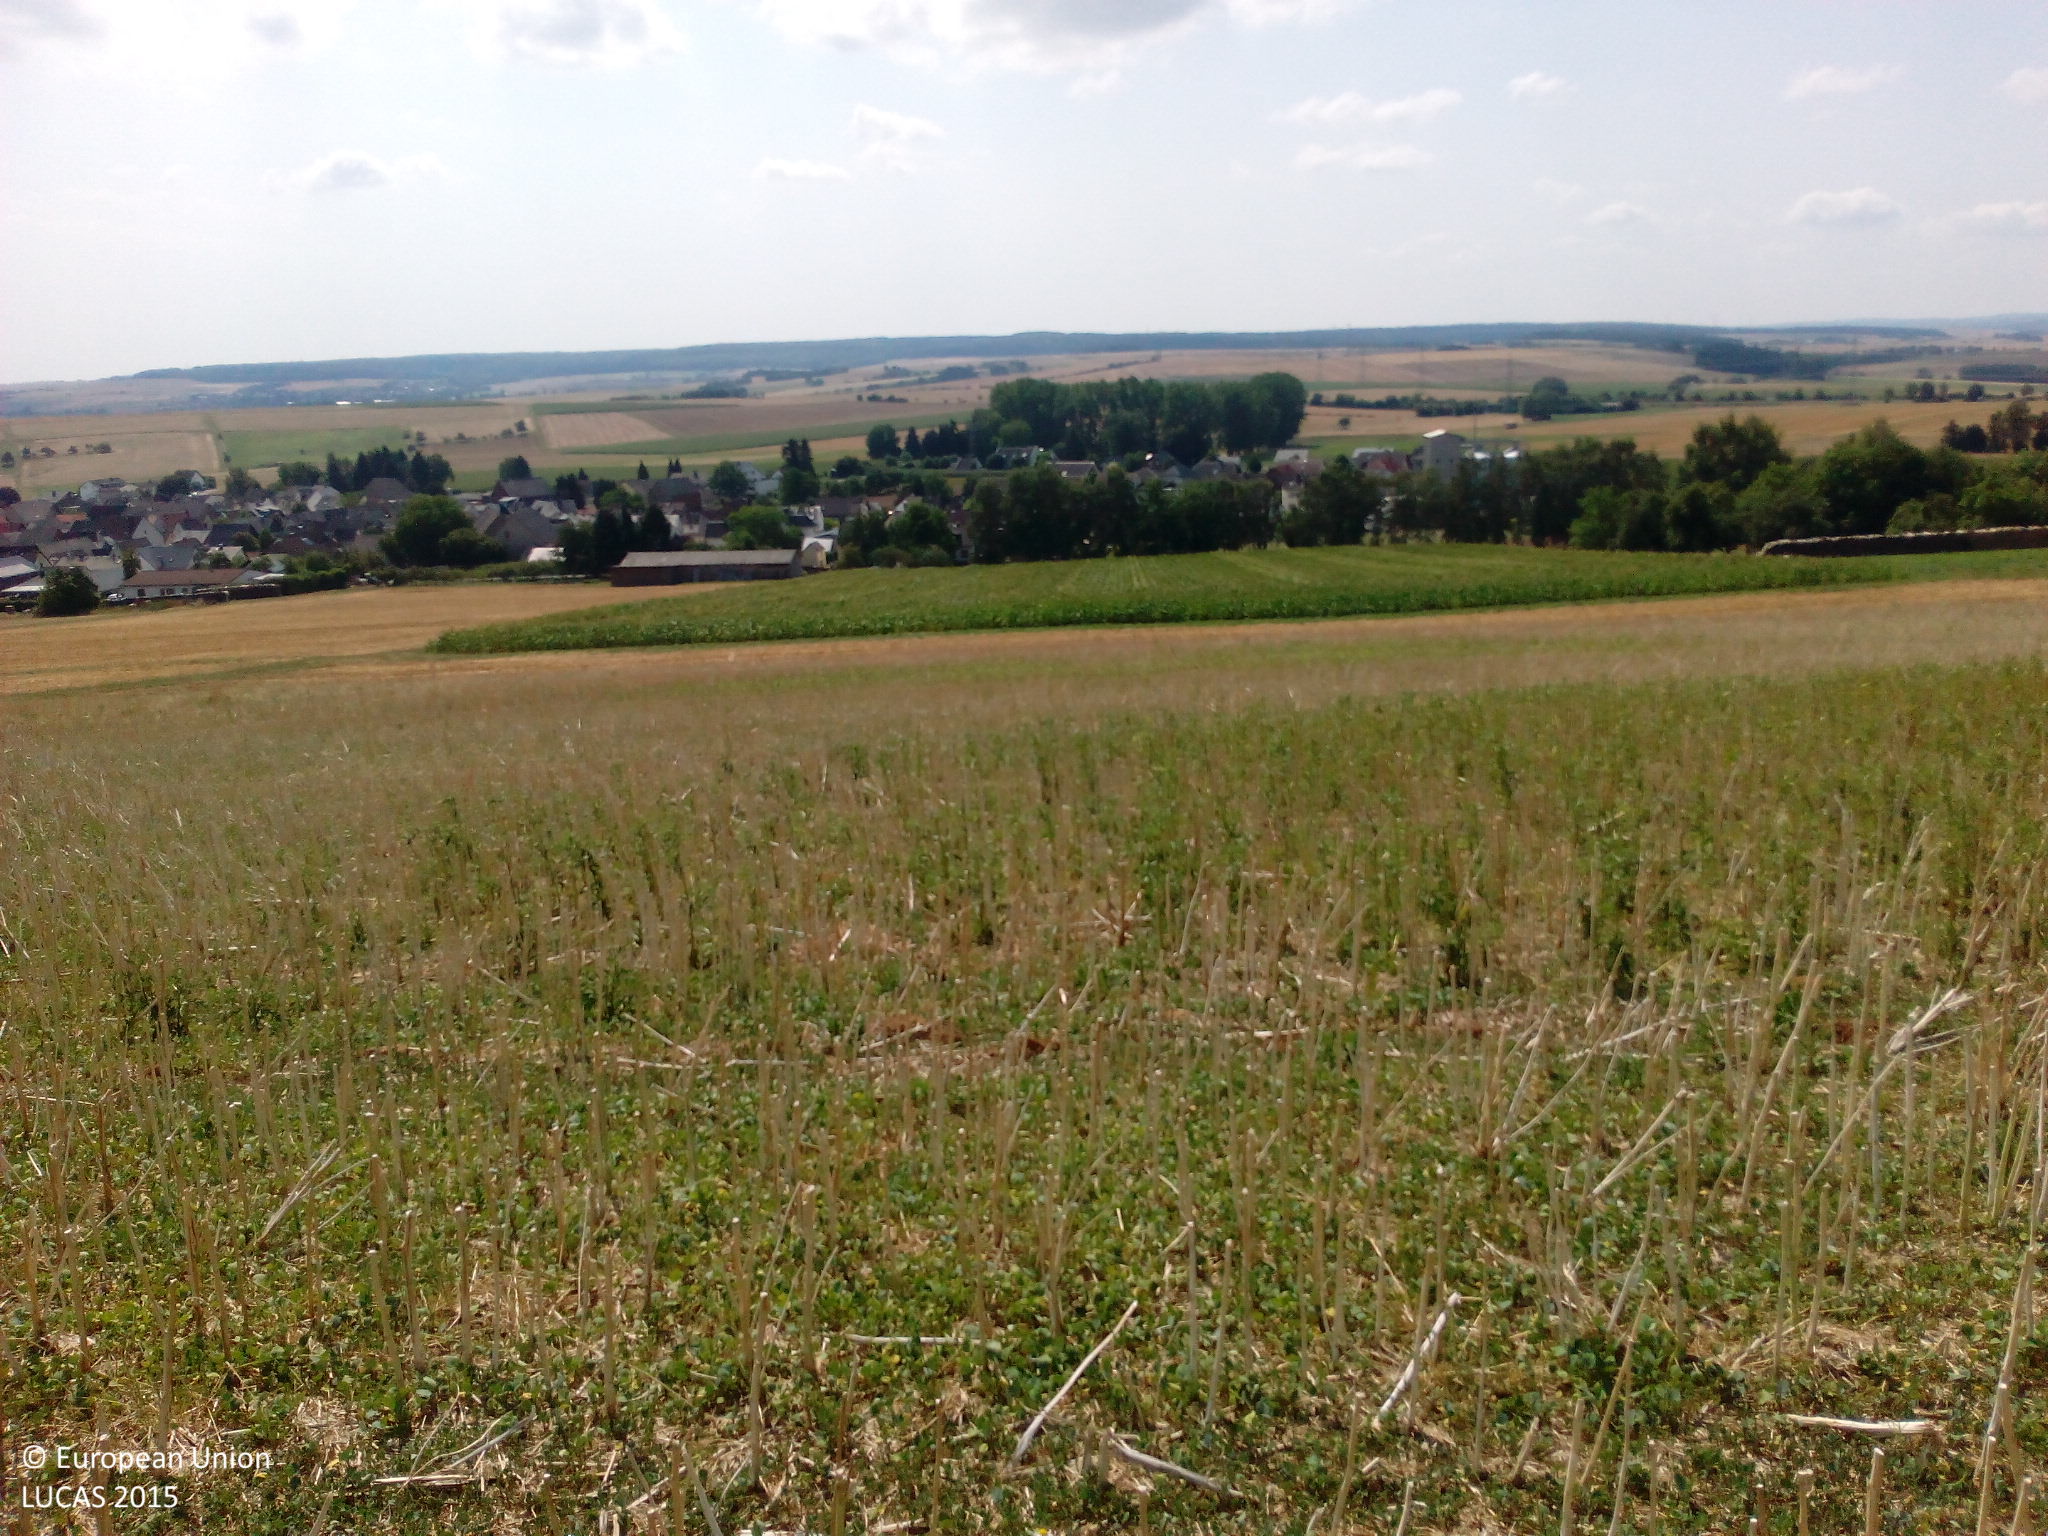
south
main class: Cropland
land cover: Rape and turnip rape
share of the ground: < 10 %
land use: Agriculture (excluding fallow land and kitchen gardens)
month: August
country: DE
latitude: 50.3488
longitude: 8.1313
